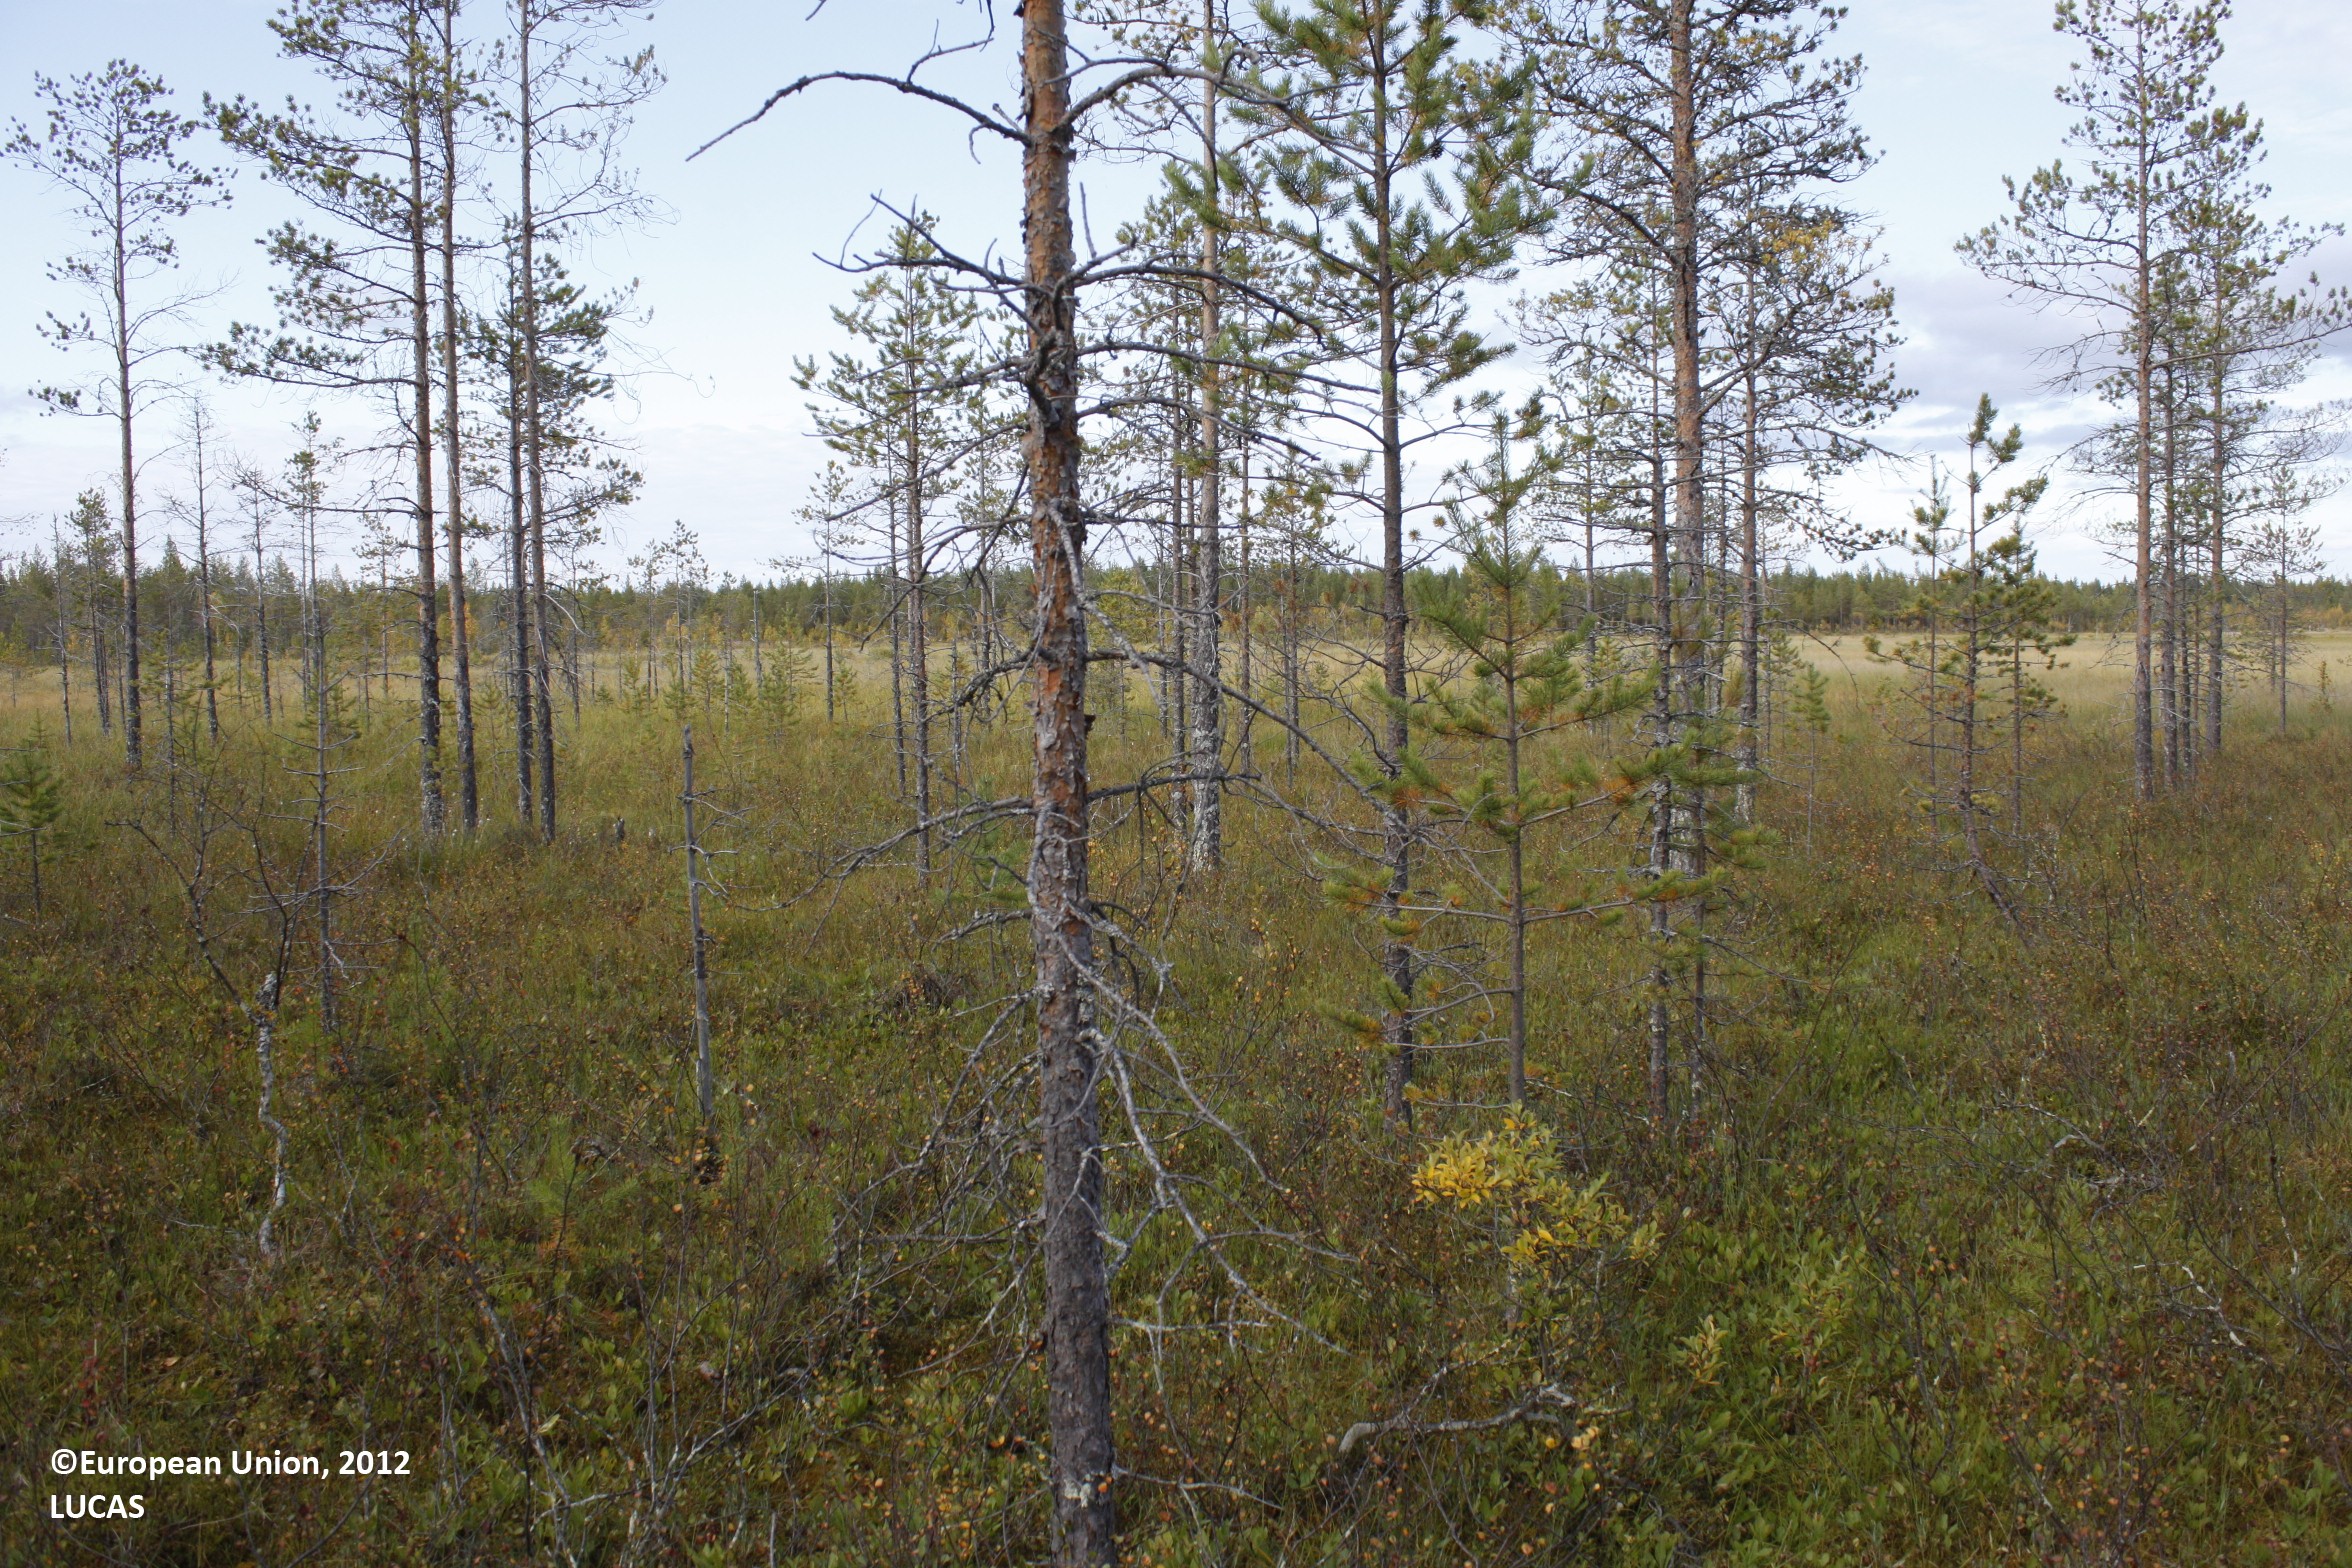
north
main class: Woodland
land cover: Pine dominated coniferous woodland
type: mire and swamp forests
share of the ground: 25 - 50 %
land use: Semi-natural and natural areas not in use
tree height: > 5 m
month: September
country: FI
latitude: 65.4144
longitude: 27.2479
